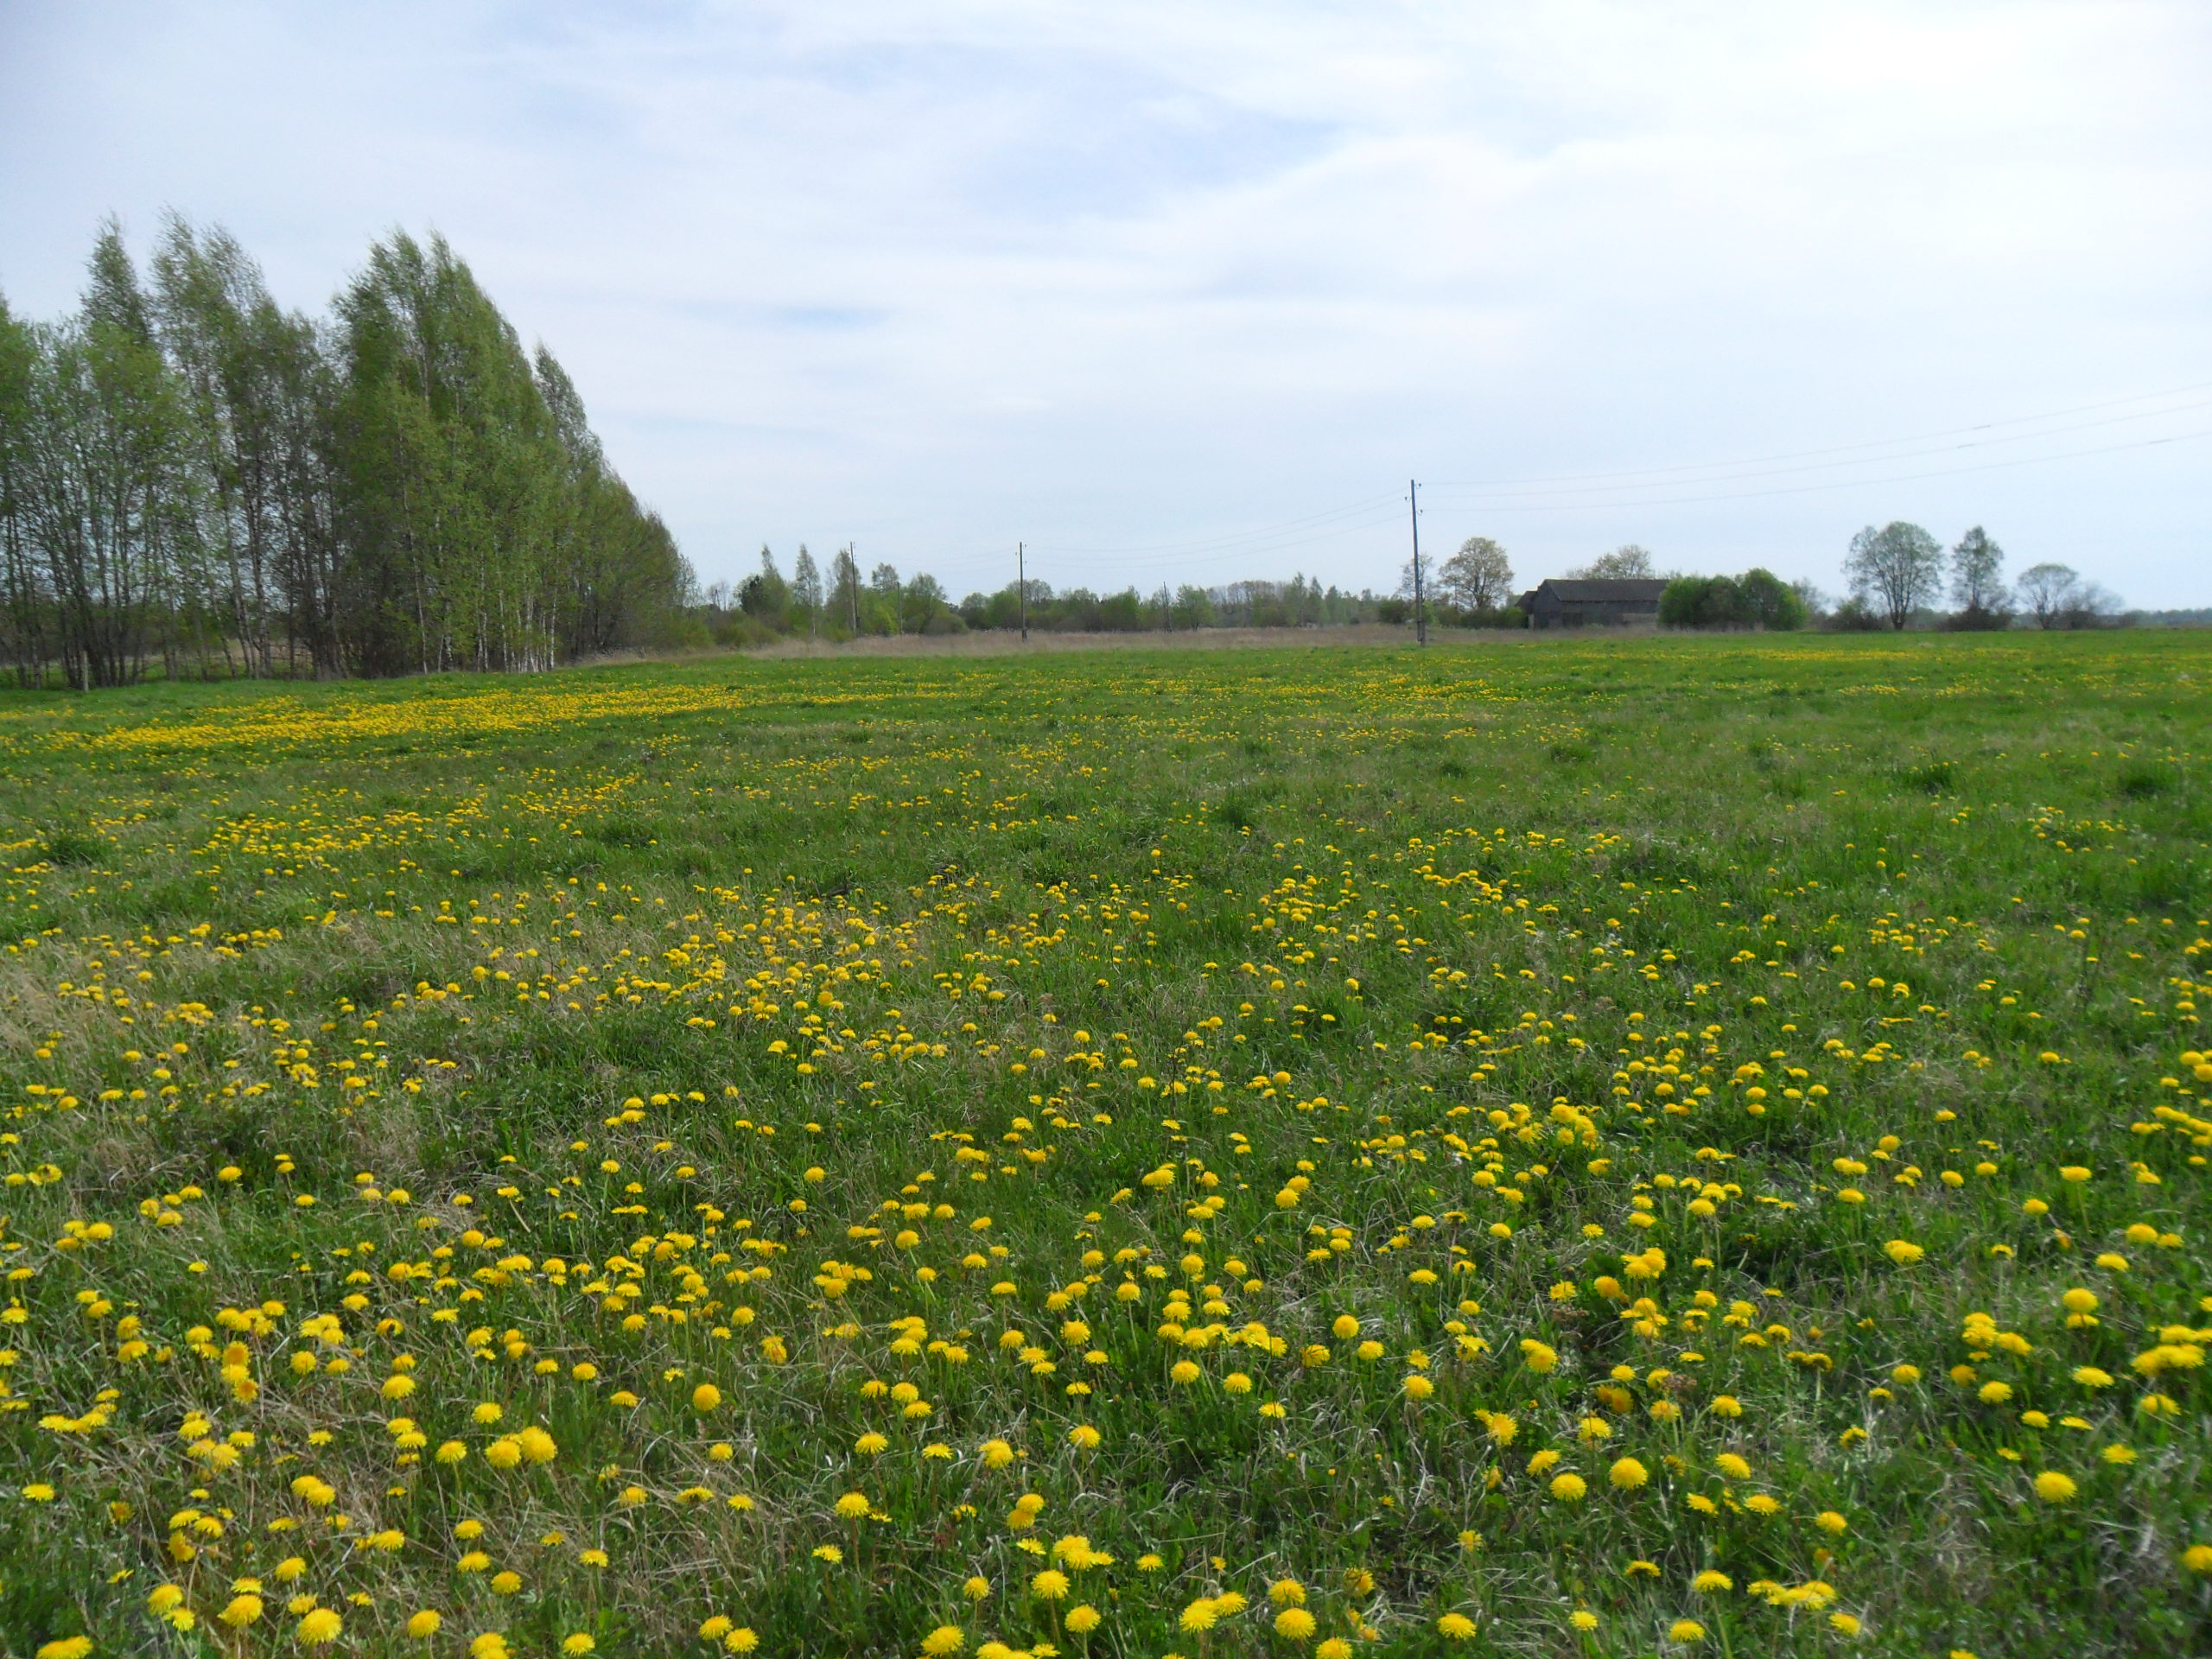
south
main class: Grassland
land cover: Grassland without tree/shrub cover
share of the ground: > 75 %
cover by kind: herbaceous plants 100 %
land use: Agriculture (excluding fallow land and kitchen gardens)
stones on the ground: < 10 %
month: May
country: LV
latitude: 57.2871
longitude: 23.0537
